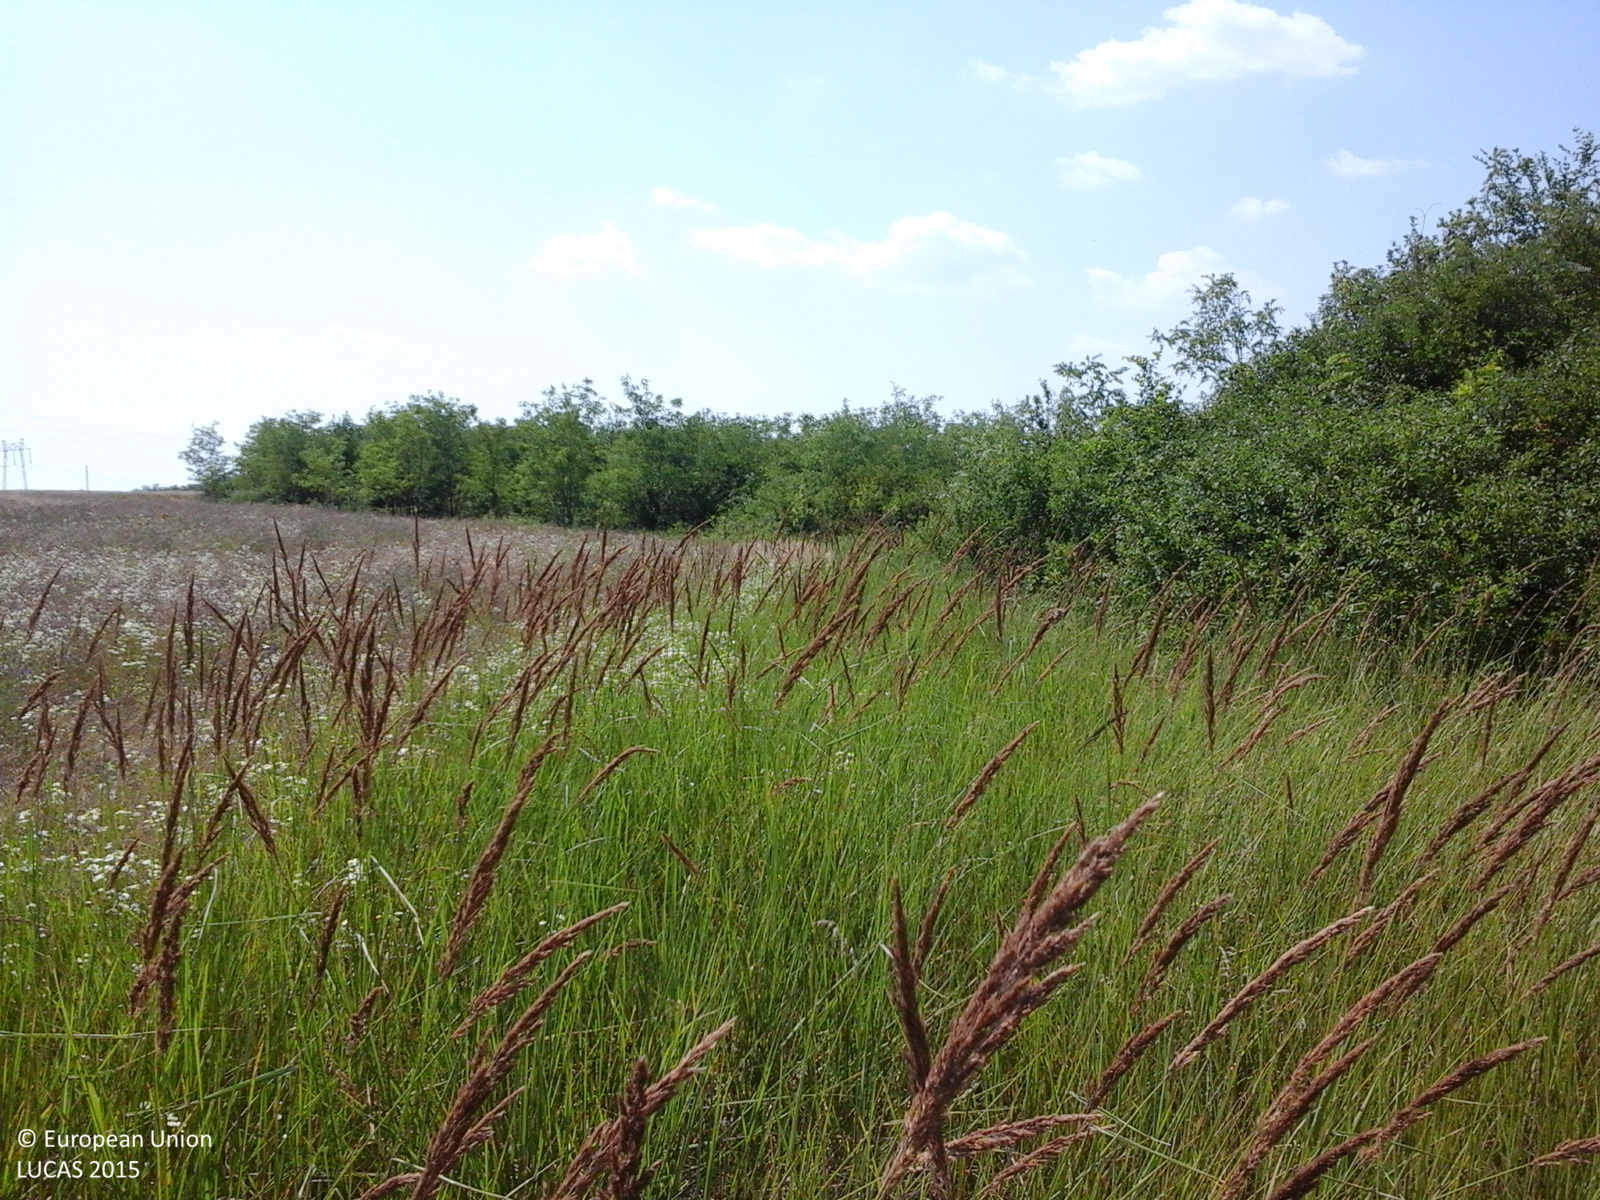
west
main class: Grassland
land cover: Spontaneously vegetated surfaces
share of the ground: > 75 %
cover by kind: herbaceous plants 100 %
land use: Fallow land
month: July
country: RO
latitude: 44.7375
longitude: 24.6106
